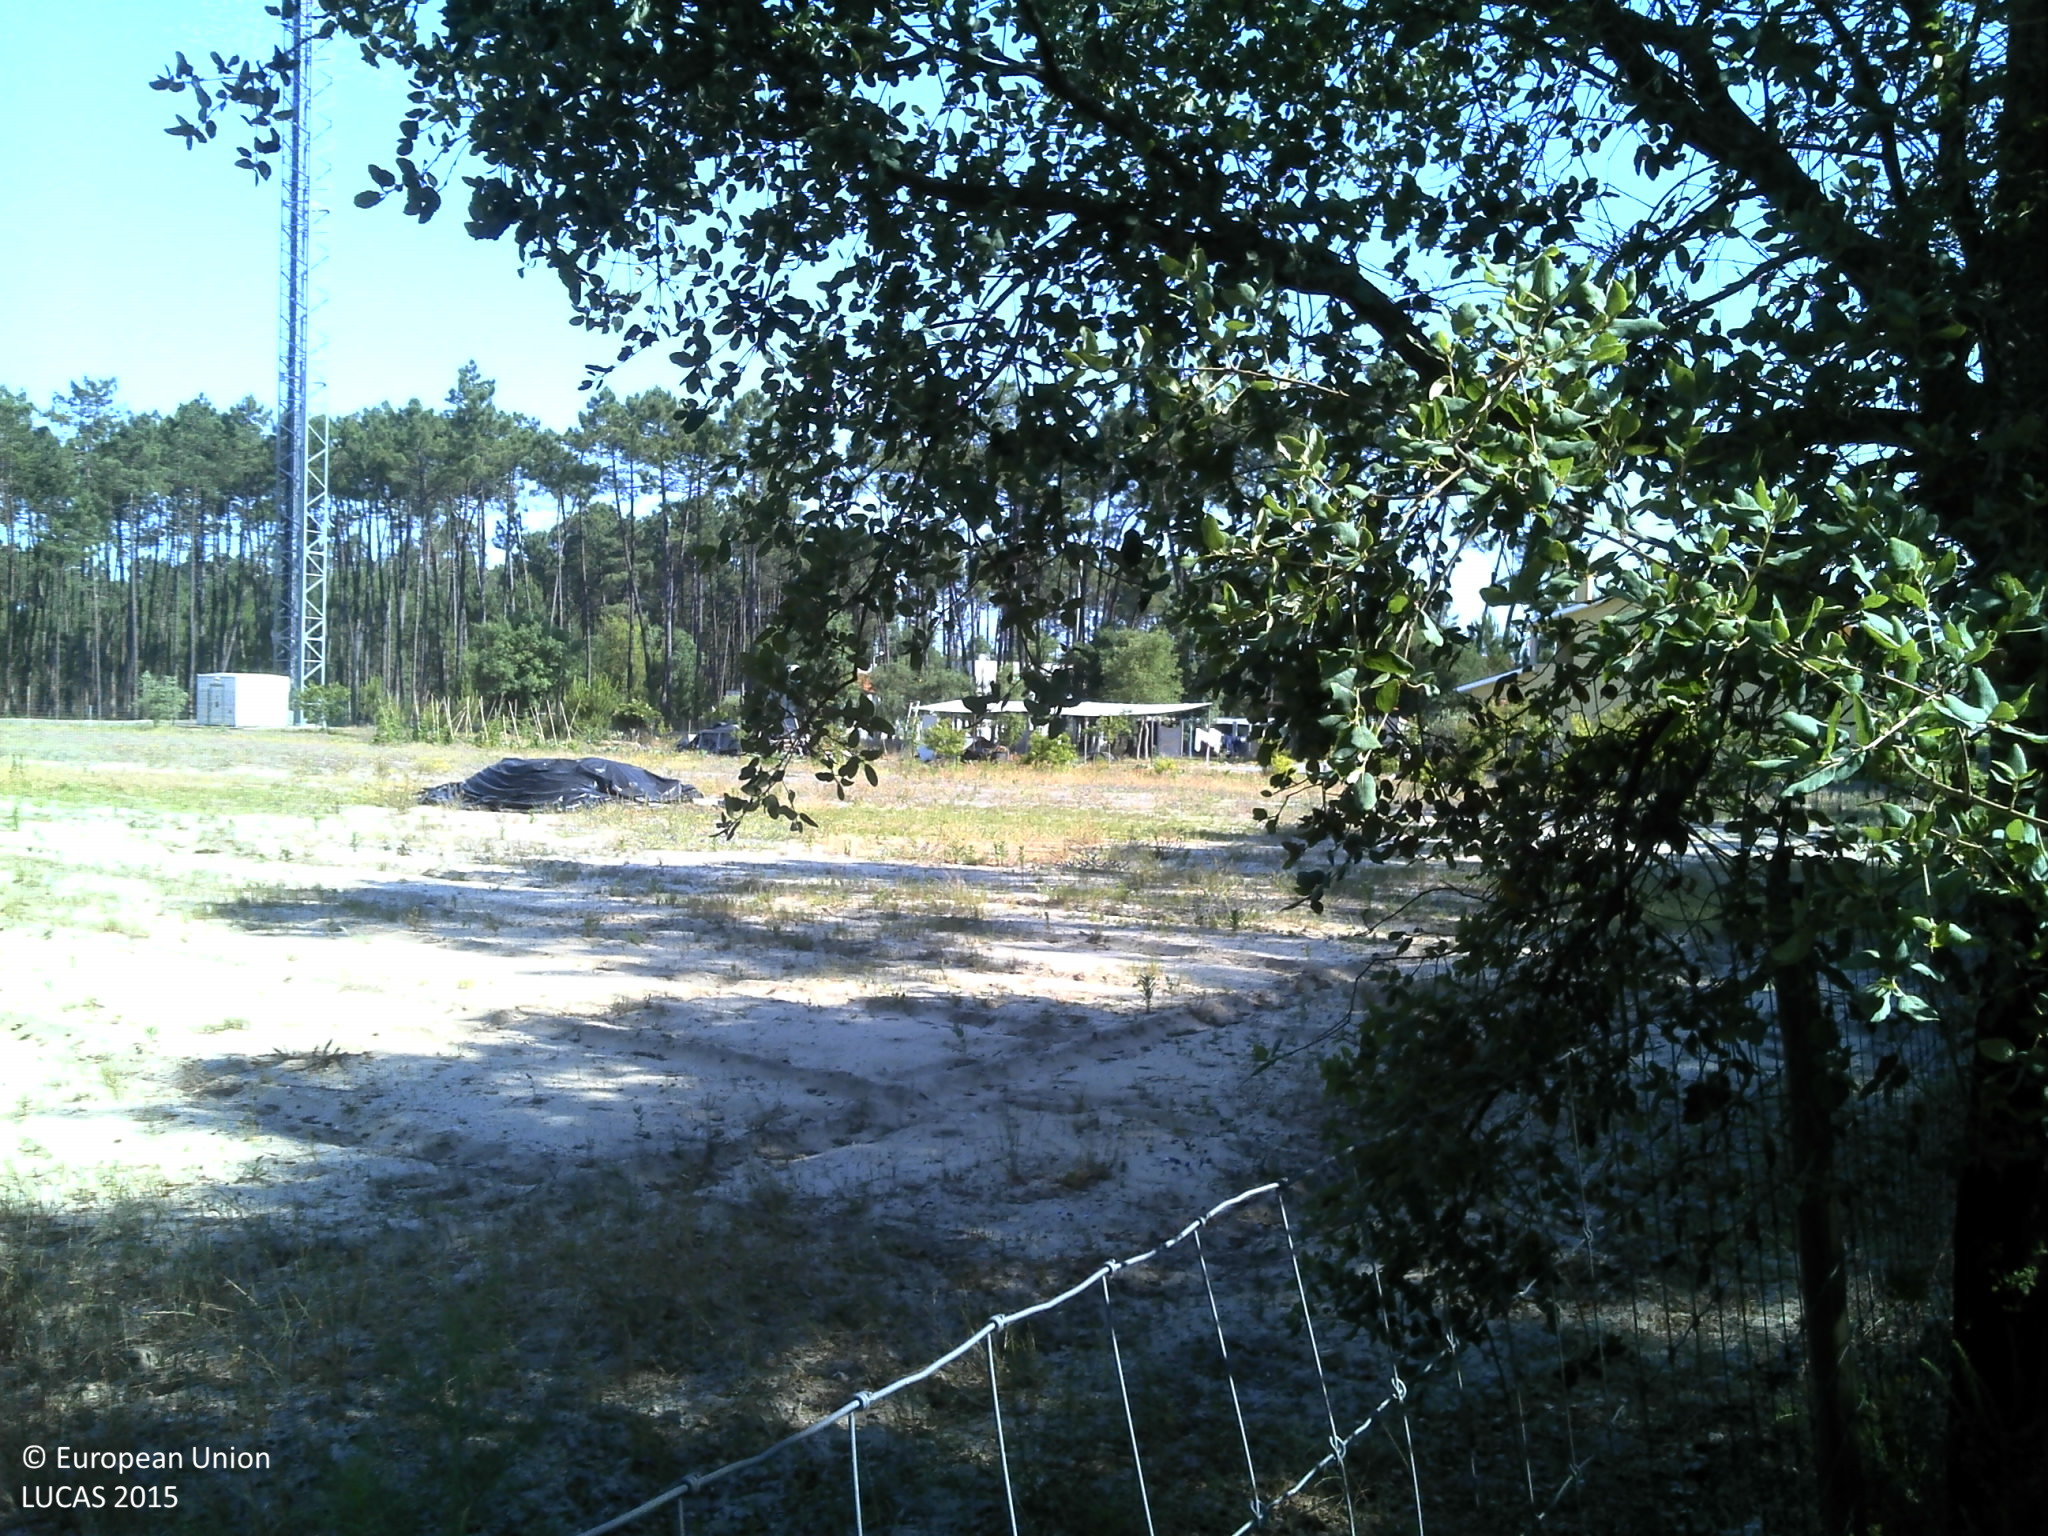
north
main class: Woodland
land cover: Pine dominated coniferous woodland
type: coniferous forest of the mediterranean region
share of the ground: 50 - 75 %
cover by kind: coniferous forest trees 60 %, unconsolidated bare surface 35 %, herbaceous plants 5 %
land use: Forestry
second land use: Agriculture (excluding fallow land and kitchen gardens)
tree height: > 5 m
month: June
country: PT
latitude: 40.3556
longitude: -8.7098
